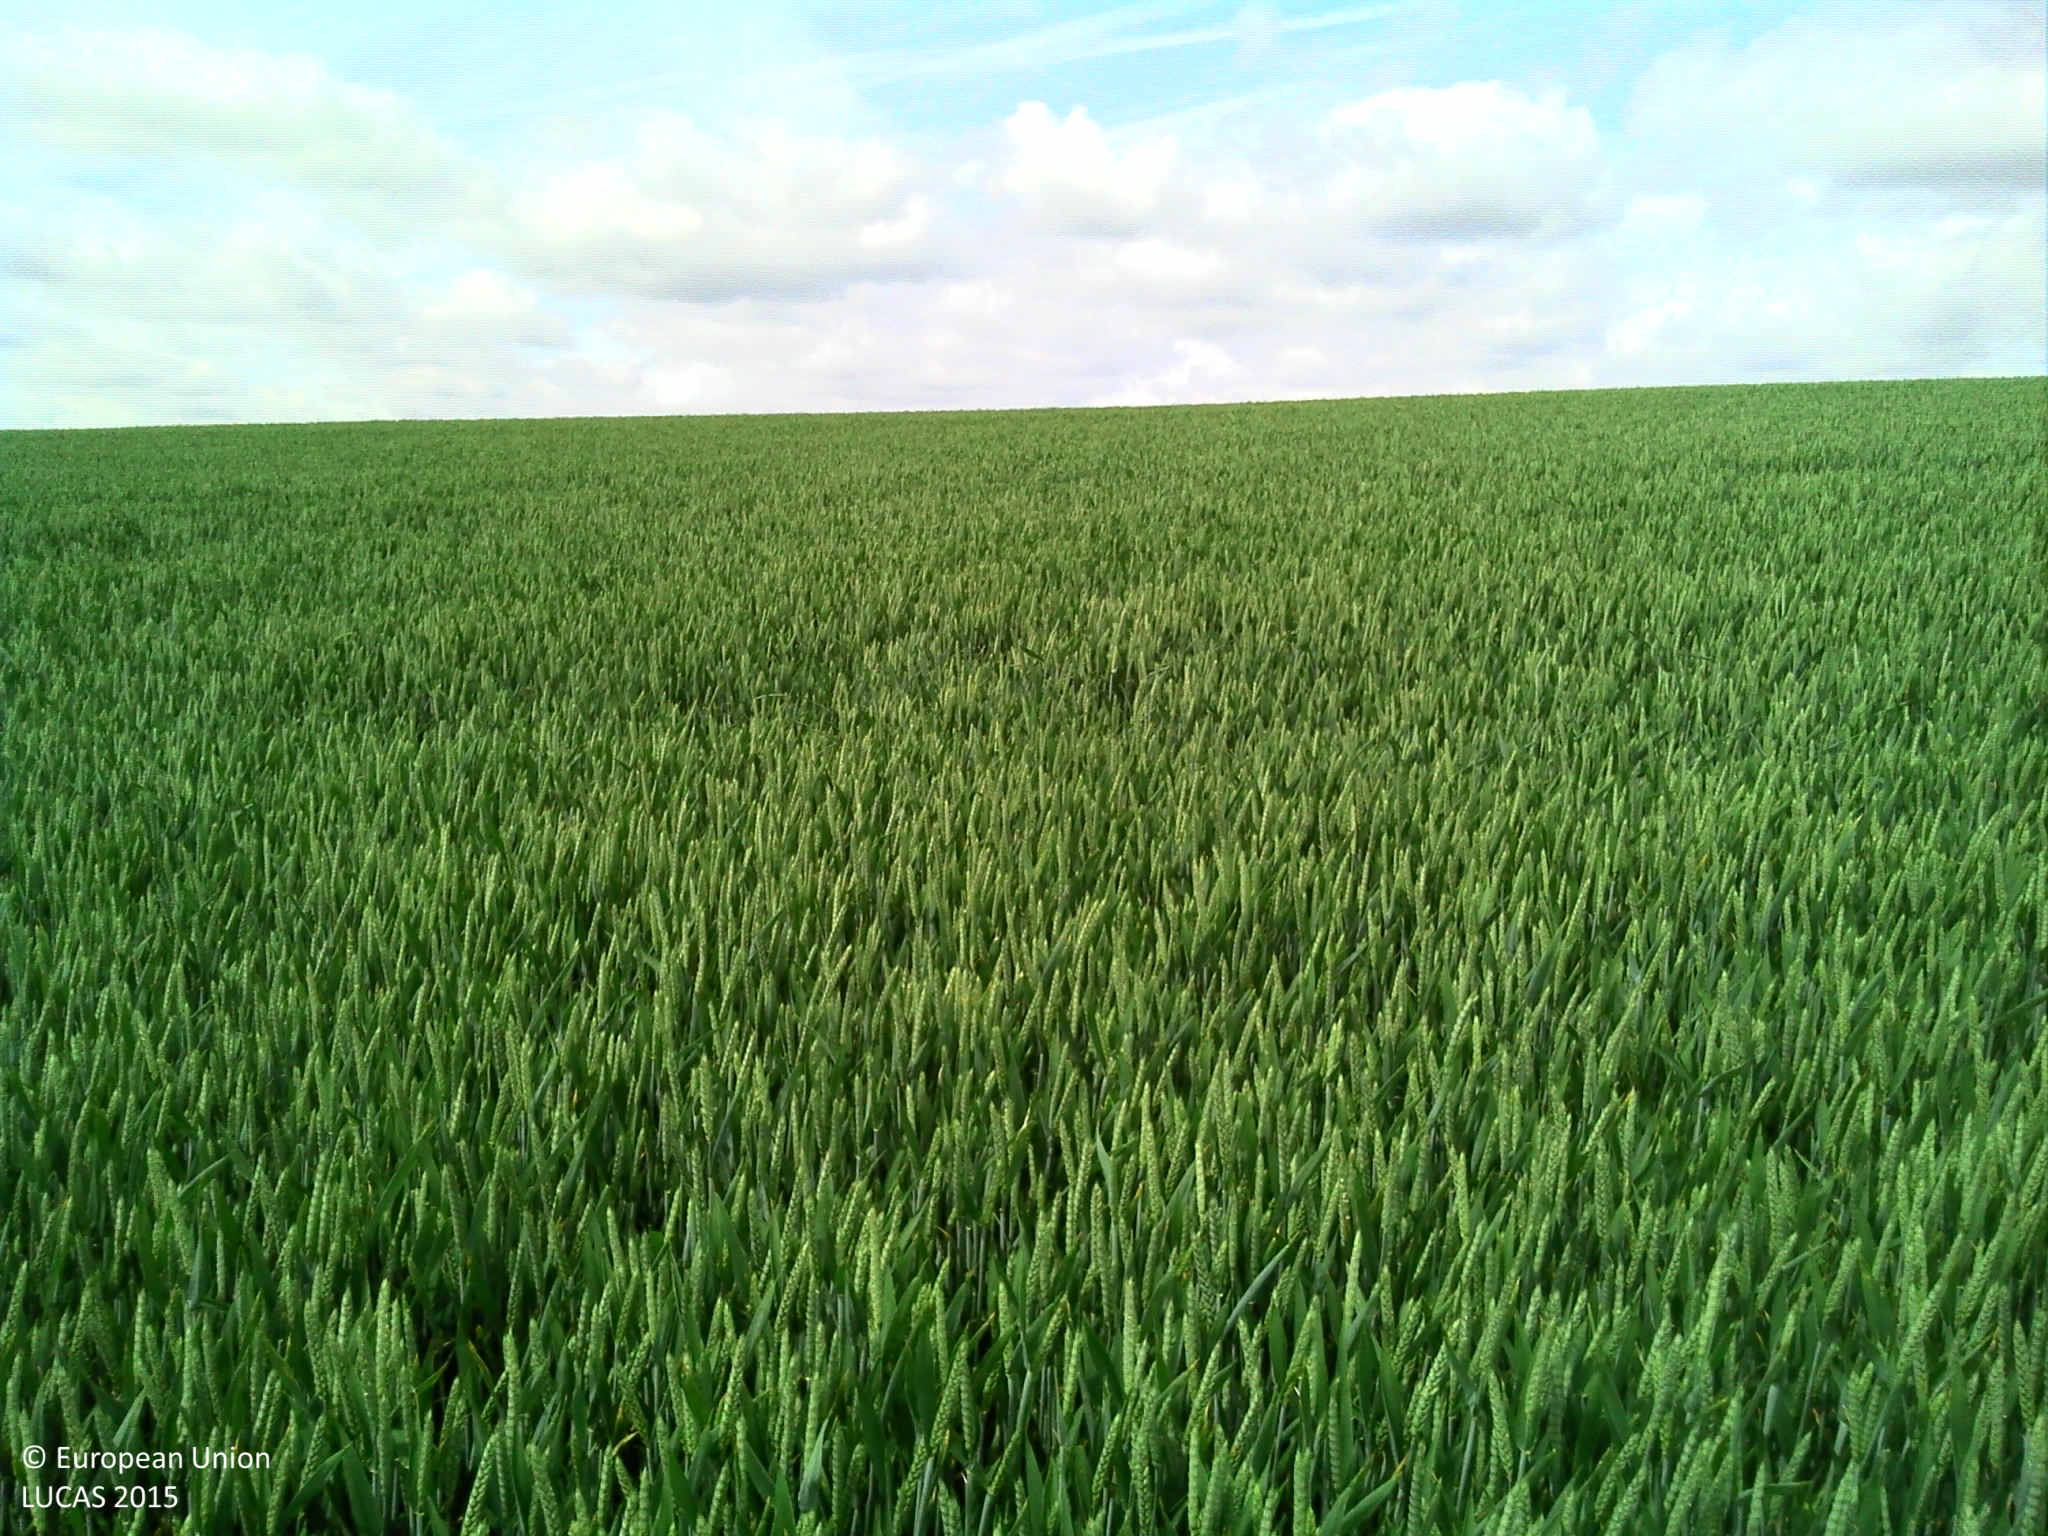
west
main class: Cropland
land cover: Common wheat
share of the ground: > 75 %
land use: Agriculture (excluding fallow land and kitchen gardens)
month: May
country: FR
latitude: 49.8005
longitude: 3.1973
